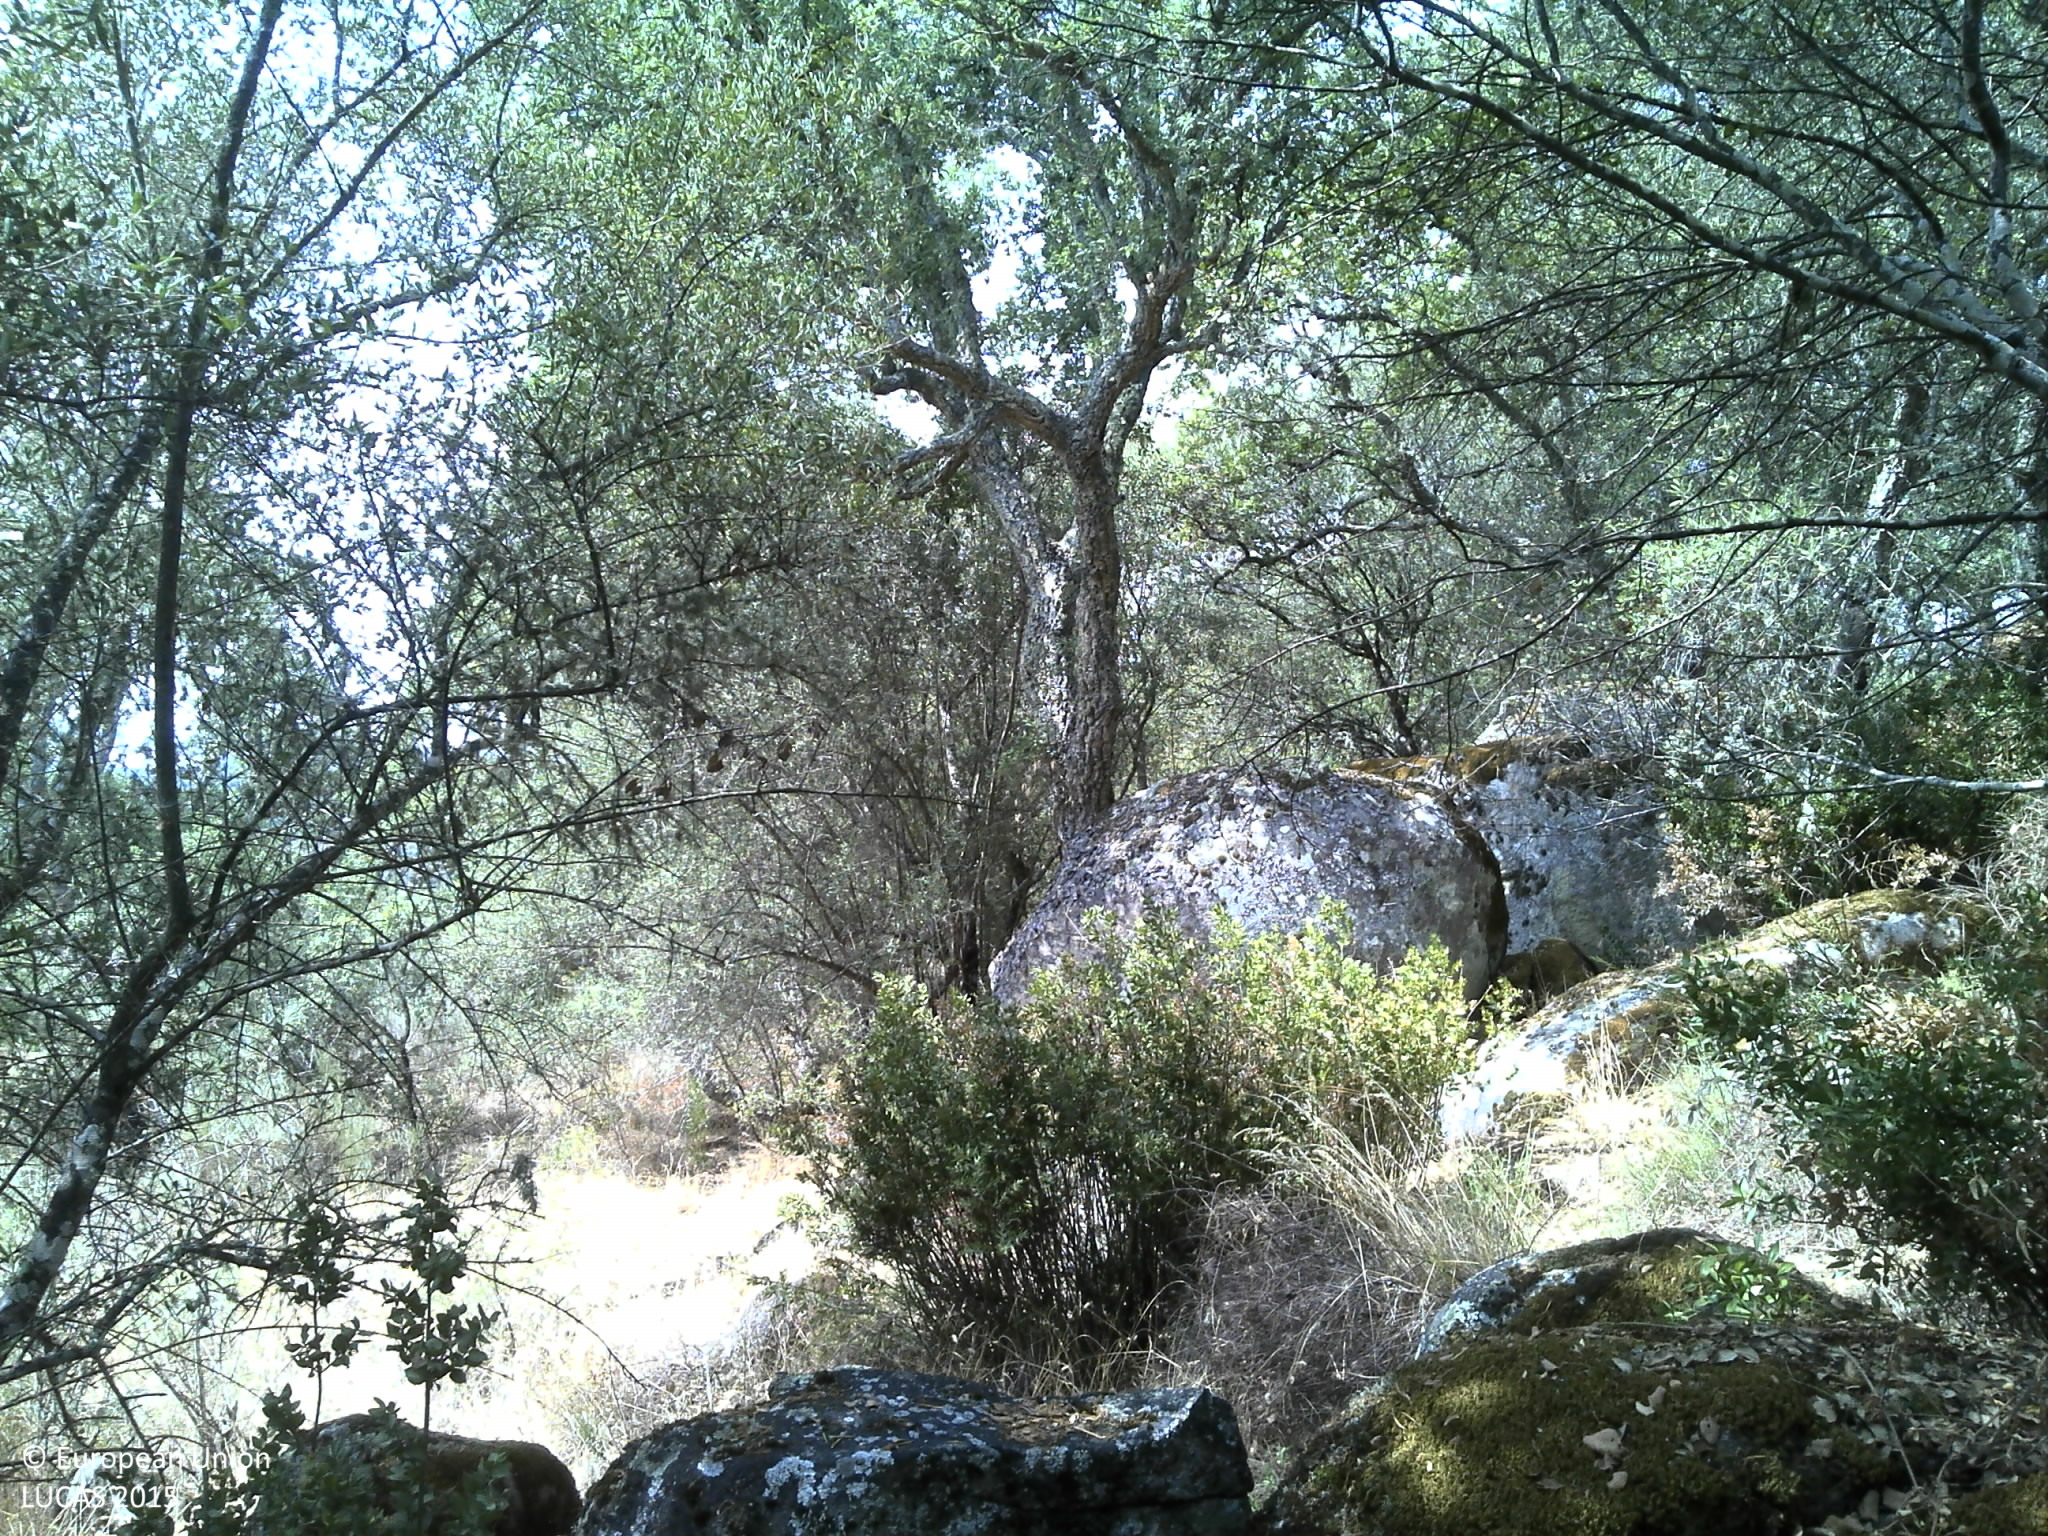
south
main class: Woodland
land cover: Broadleaved woodland
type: broadleaved evergreen forest
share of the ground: 25 - 50 %
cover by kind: broadleaved forest trees 50 %, consolidated bare surface 50 %
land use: Forestry
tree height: > 5 m
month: August
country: PT
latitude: 39.2778
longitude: -7.4650
